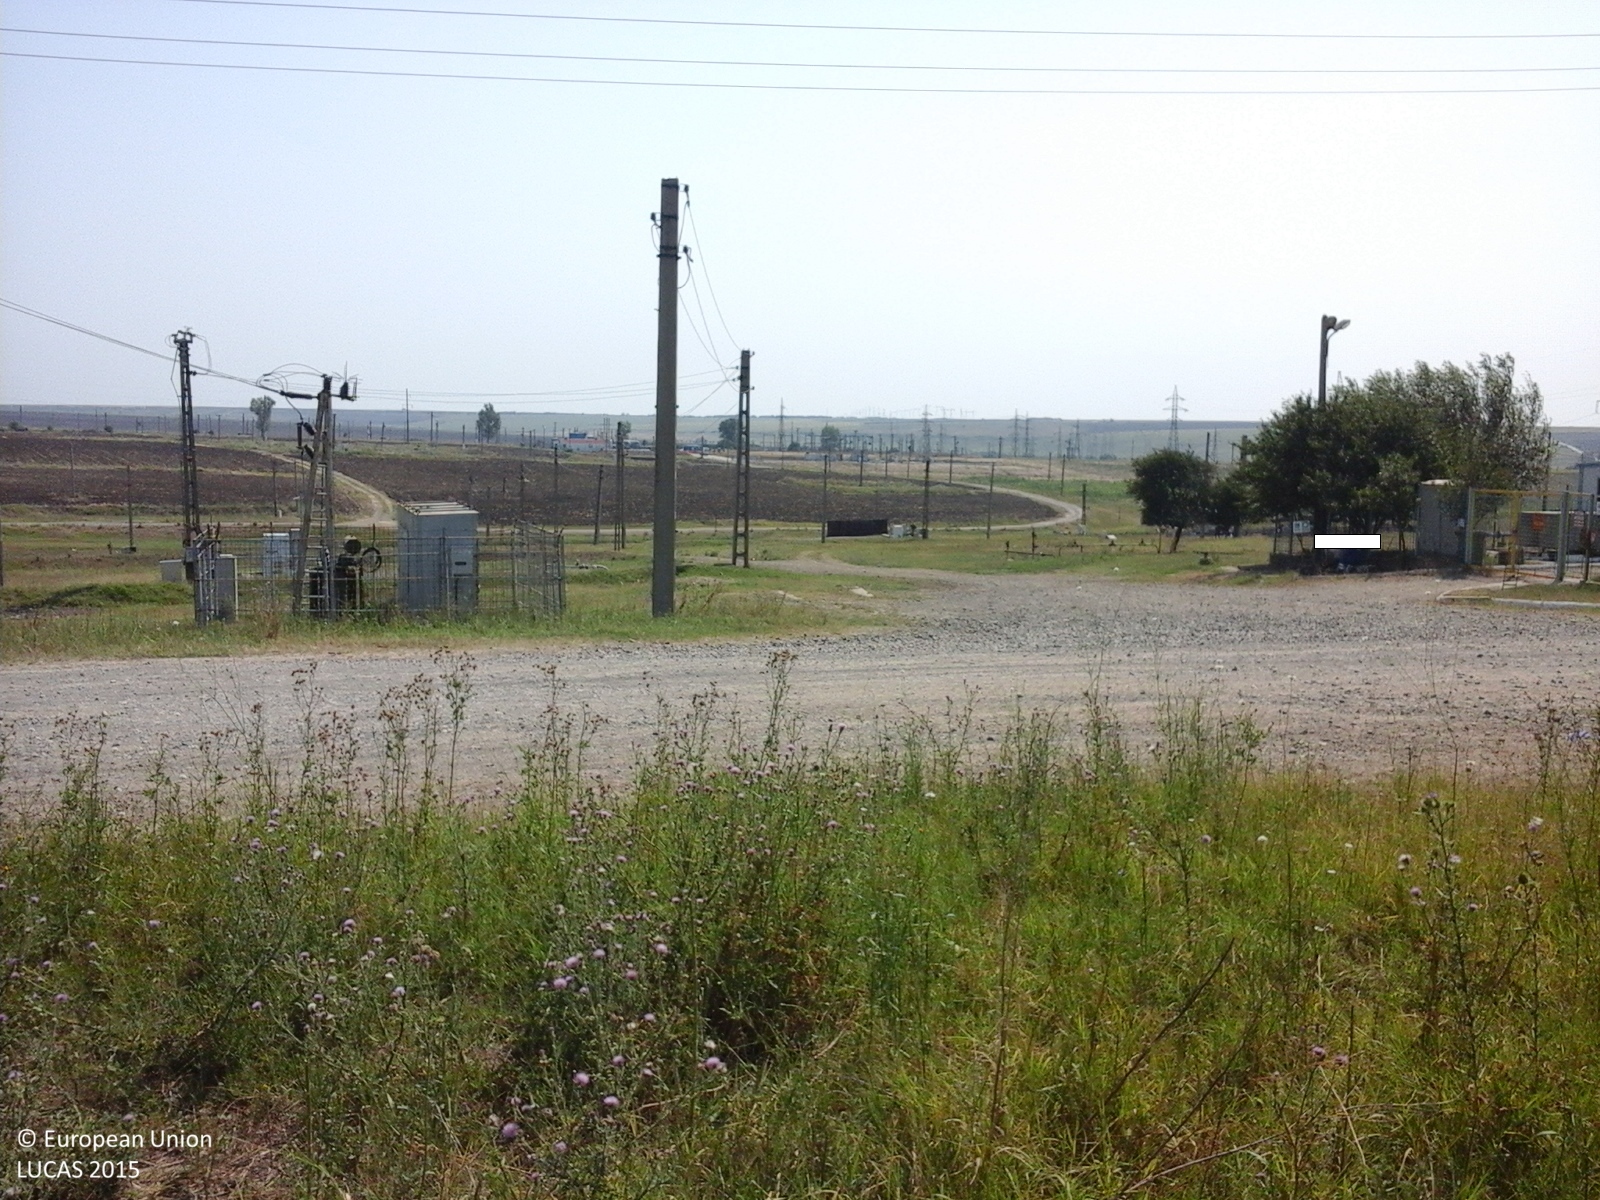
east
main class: Grassland
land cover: Grassland without tree/shrub cover
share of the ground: > 75 %
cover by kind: herbaceous plants 100 %
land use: Agriculture (excluding fallow land and kitchen gardens)
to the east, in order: Grassland without tree/shrub cover; Electric lines; Paved roads, cycling and walking lanes; Electric lines; Paved roads, cycling and walking lanes; Ditches and canals; Electric lines; Grassland without tree/shrub cover; Electric lines; Grassland without tree/shrub cover; Tracks; Grassland without tree/shrub cover; Electric lines; Grassland without tree/shrub cover; Tracks; Grassland without tree/shrub cover; Ditches and canals; Grassland without tree/shrub cover; Tracks; Grass margins; Other bare soil
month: July
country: RO
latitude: 45.5213
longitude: 27.8180
